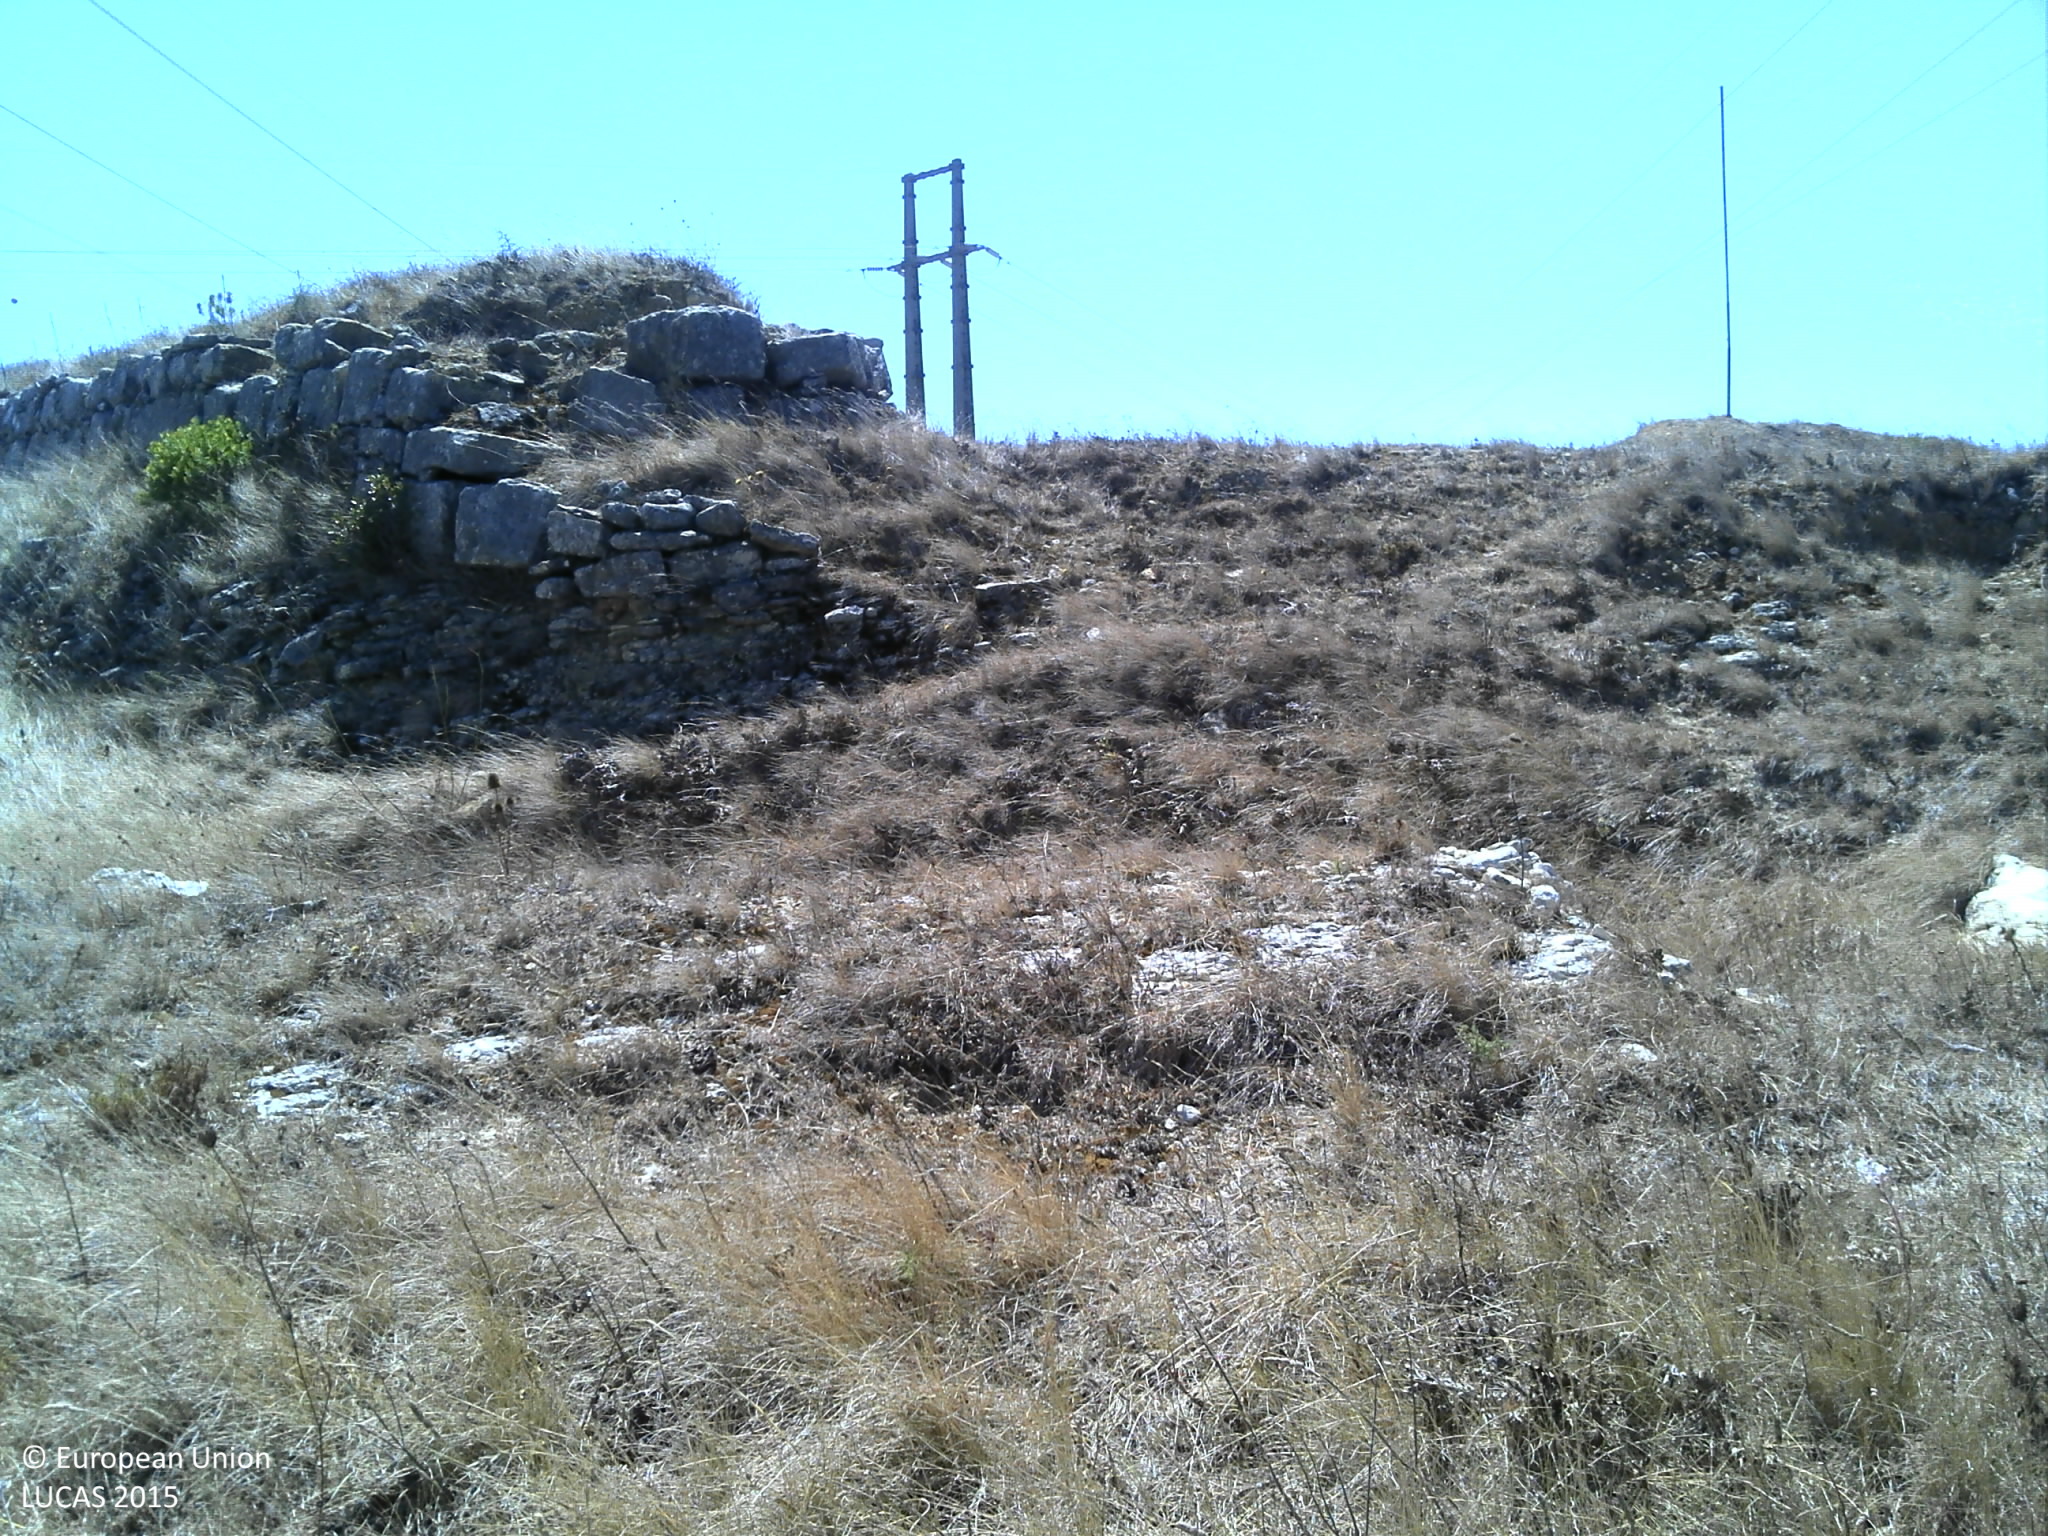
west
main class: Grassland
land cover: Grassland without tree/shrub cover
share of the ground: 50 - 75 %
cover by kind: herbaceous plants 70 %, unconsolidated bare surface 30 %
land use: Semi-natural and natural areas not in use
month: August
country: PT
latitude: 38.8961
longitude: -9.1613
